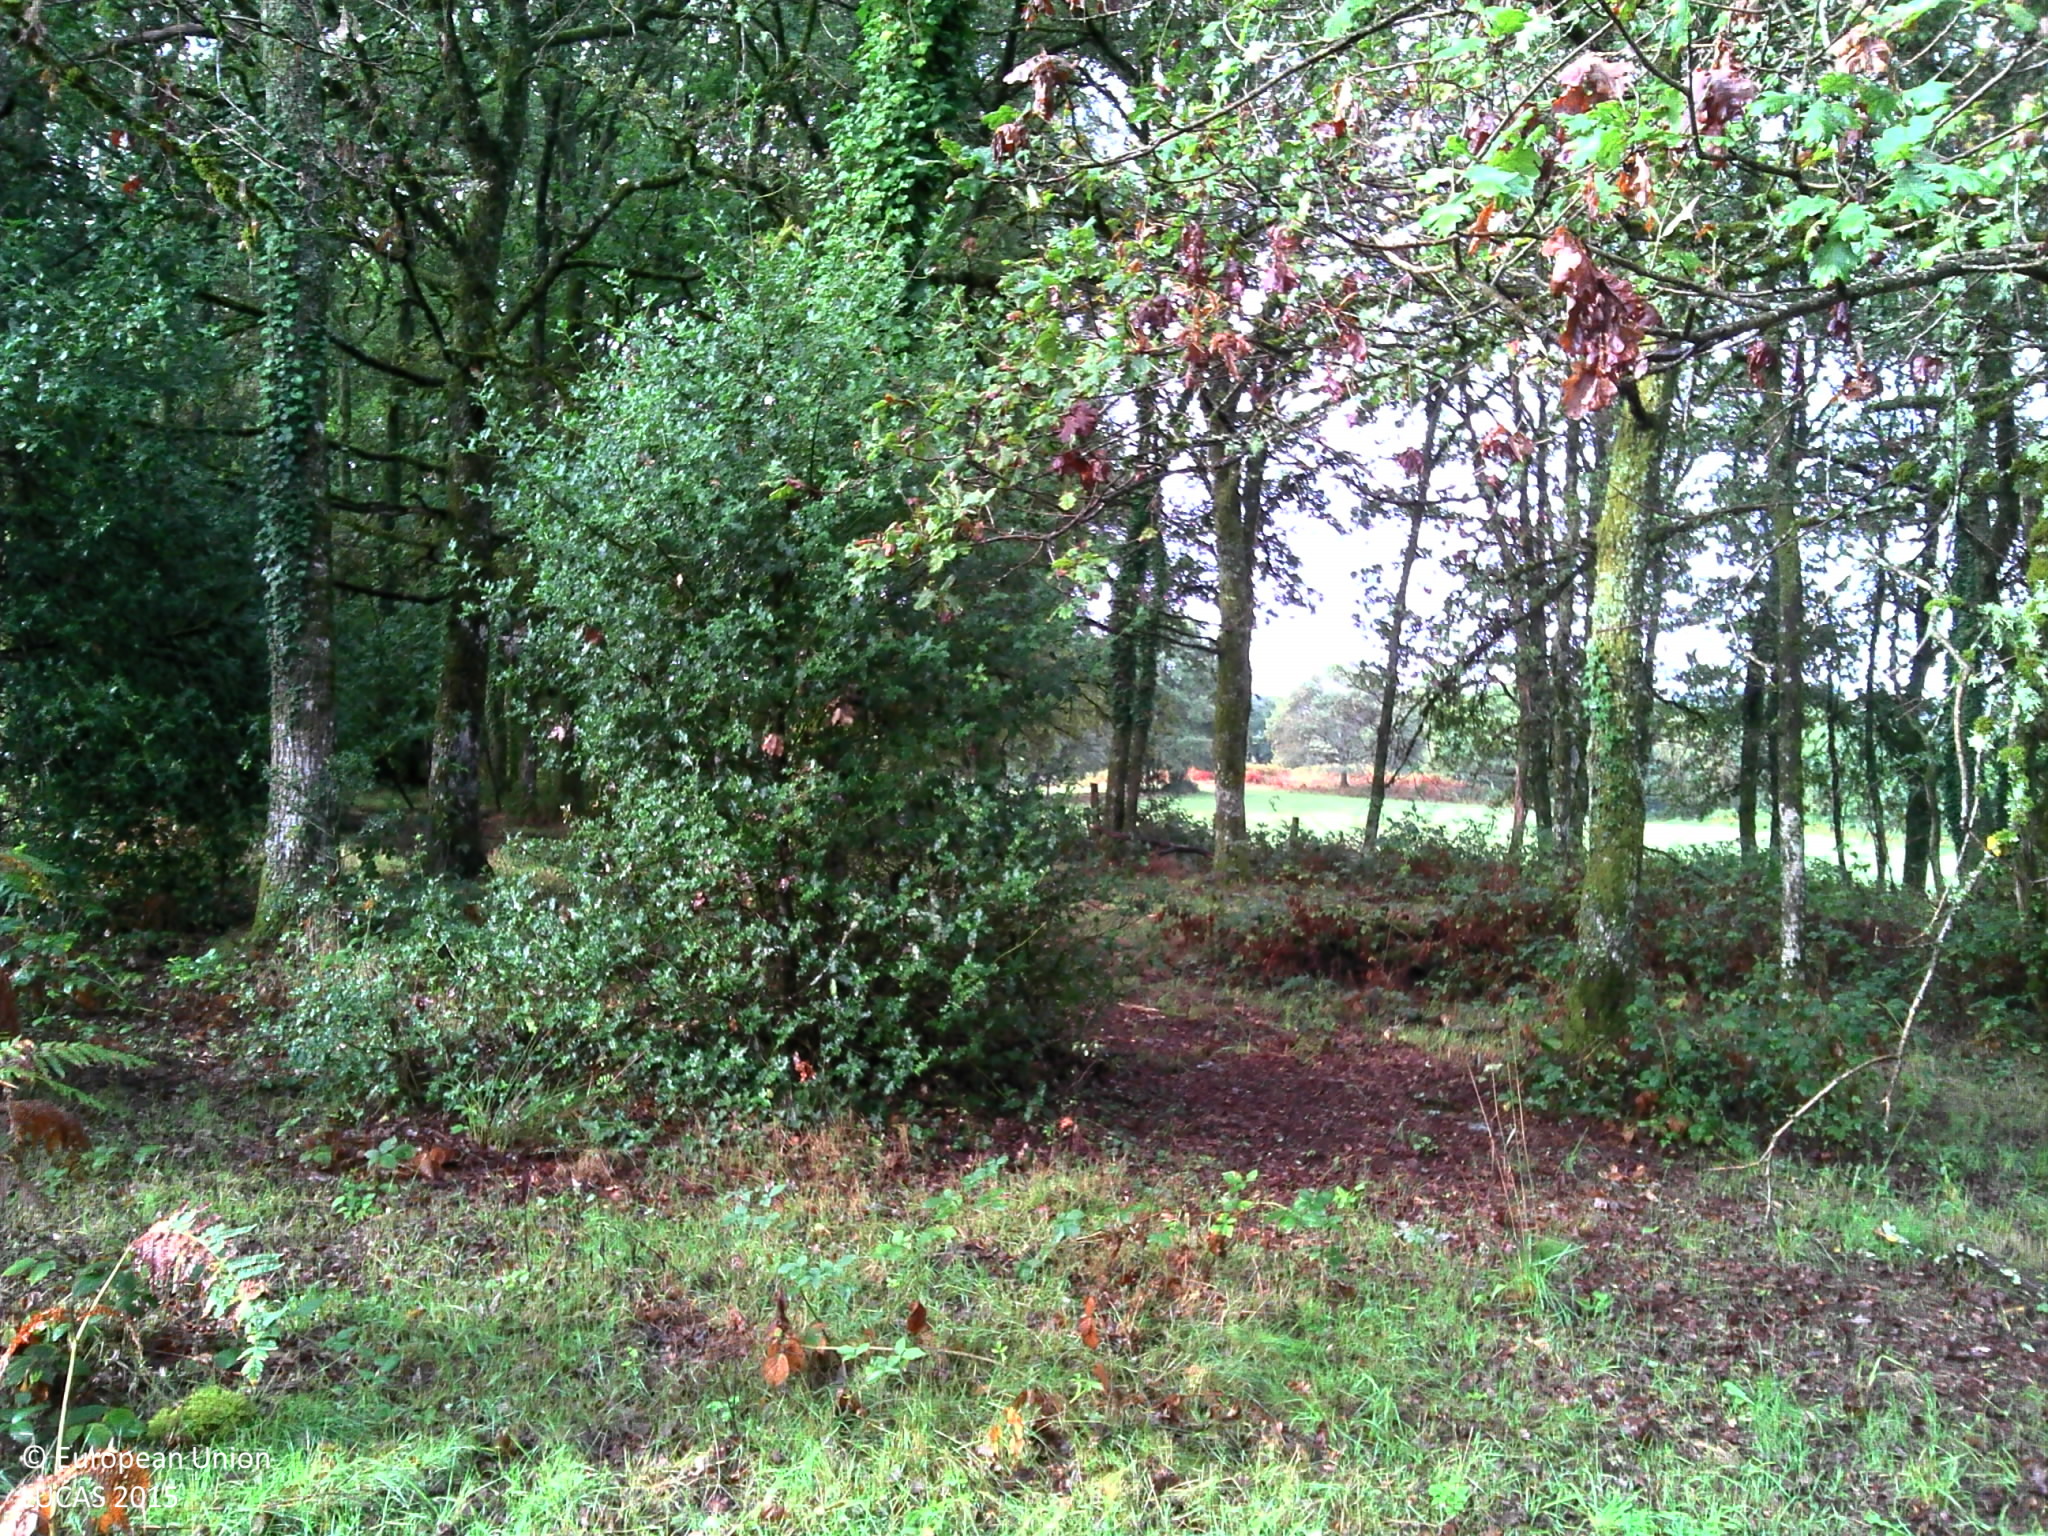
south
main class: Woodland
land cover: Broadleaved woodland
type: thermophilous deciduous forest
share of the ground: 50 - 75 %
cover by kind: herbaceous plants 70 %, broadleaved forest trees 30 %
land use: Forestry
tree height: > 5 m
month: August
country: FR
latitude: 45.5102
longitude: 1.7904
